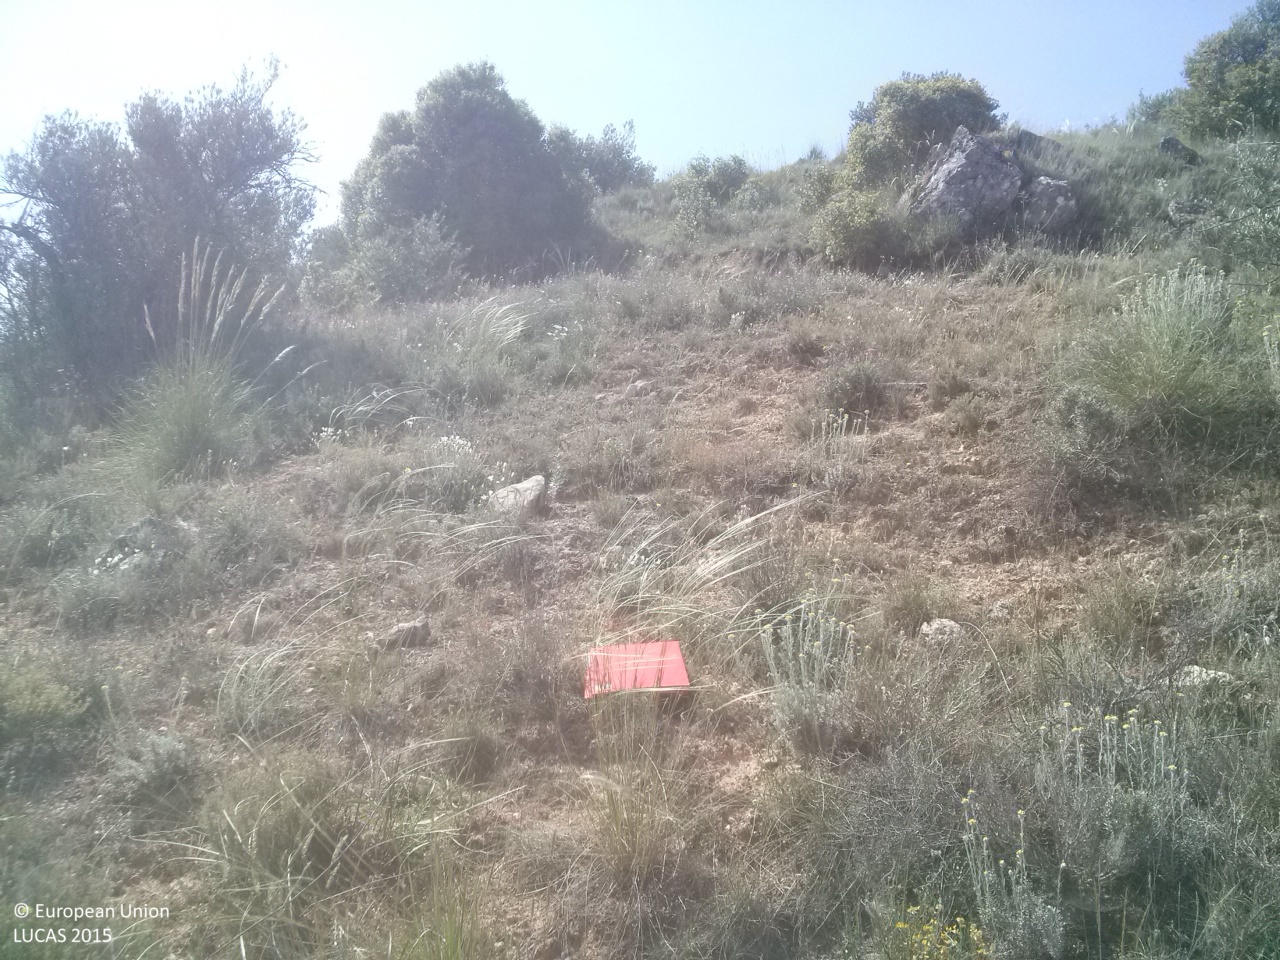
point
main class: Cropland
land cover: Olive groves
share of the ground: < 10 %
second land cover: Shrubland without tree cover
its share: 25 - 50 %
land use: Abandoned areas
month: May
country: ES
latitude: 40.1405
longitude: -2.9239
